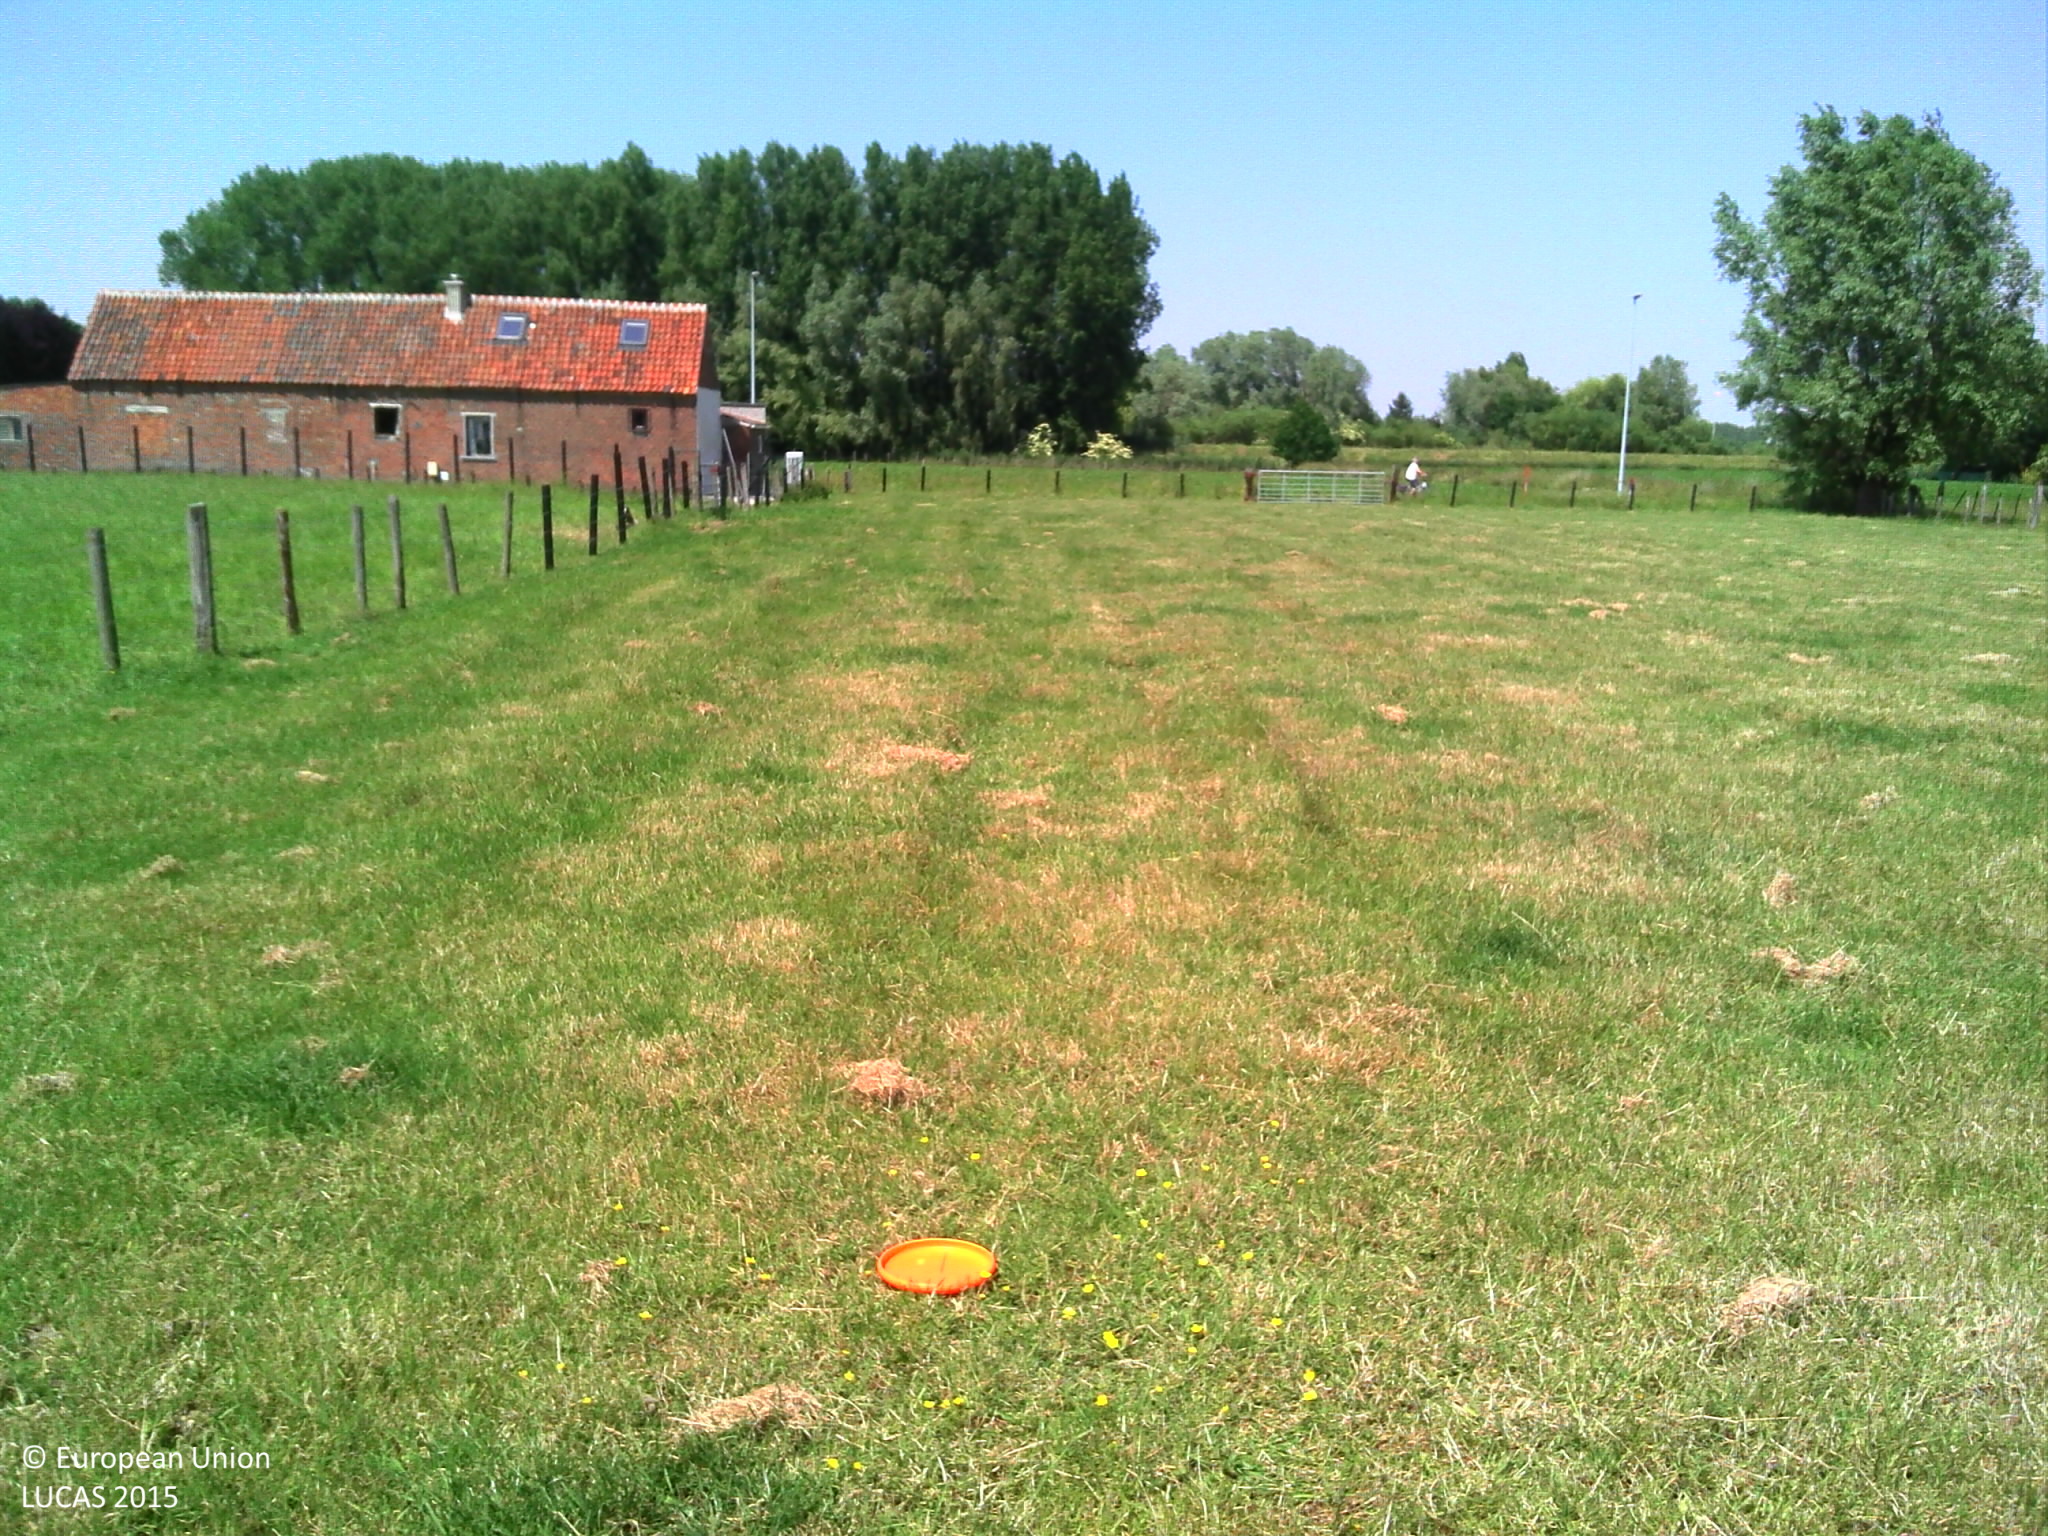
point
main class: Grassland
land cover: Grassland without tree/shrub cover
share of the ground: > 75 %
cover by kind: herbaceous plants 100 %
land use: Agriculture (excluding fallow land and kitchen gardens)
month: June
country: BE
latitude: 51.0921
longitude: 4.0403
